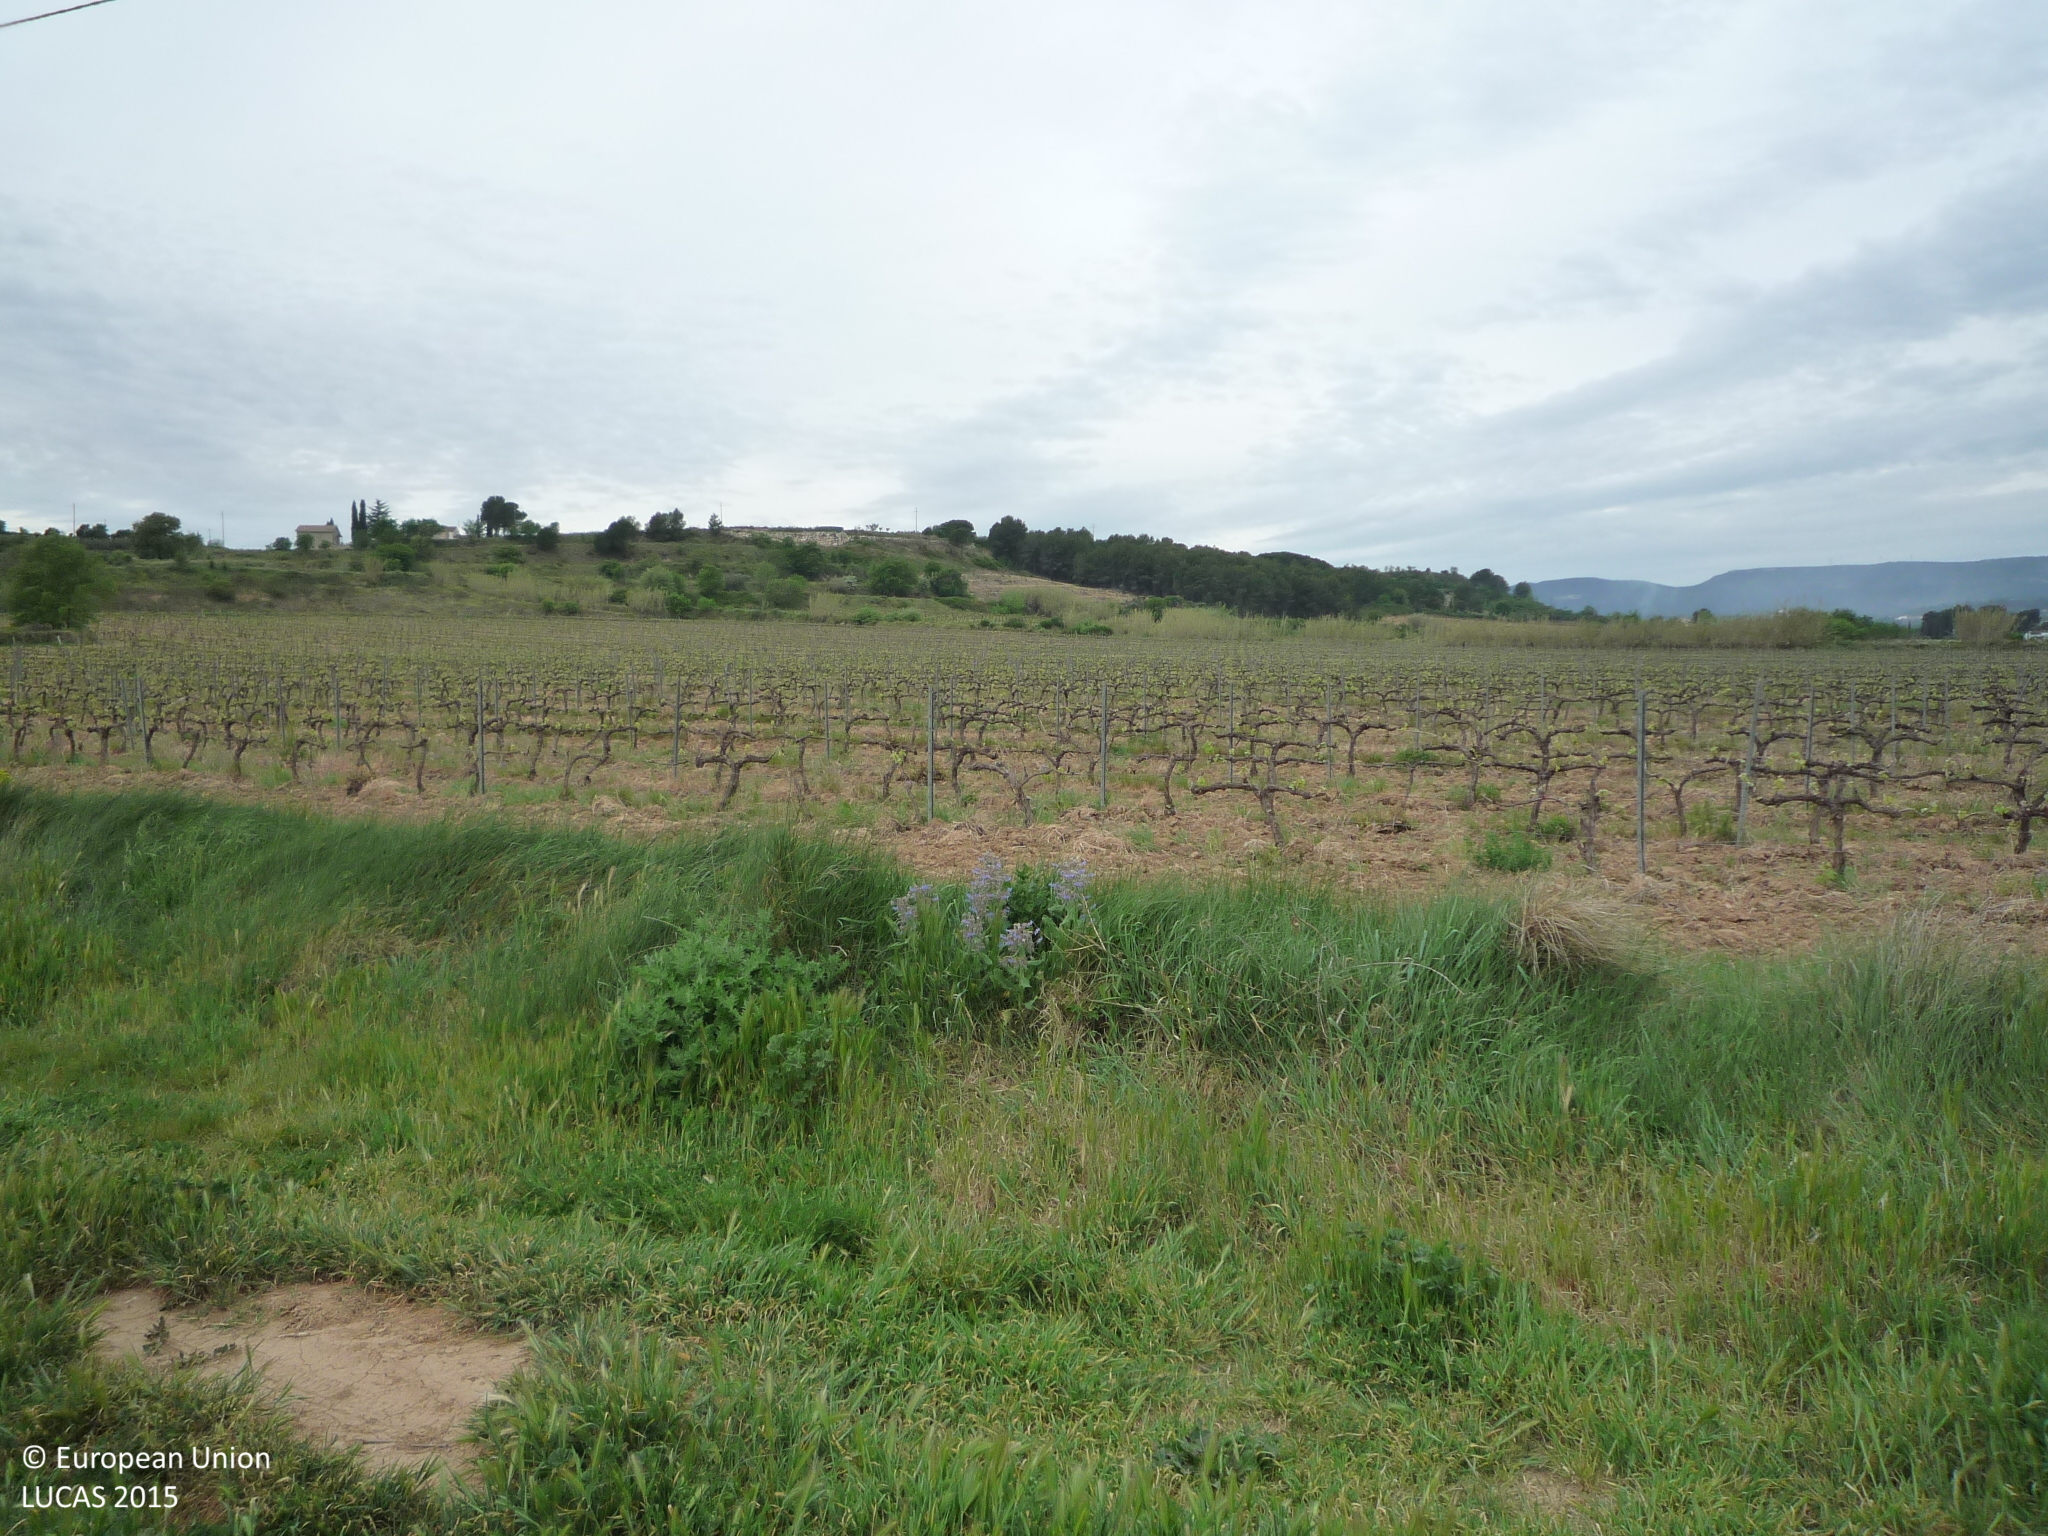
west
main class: Cropland
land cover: Vineyards
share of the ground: > 75 %
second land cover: Other bare soil
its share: > 75 %
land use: Agriculture (excluding fallow land and kitchen gardens)
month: April
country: ES
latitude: 41.4035
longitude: 1.6796
